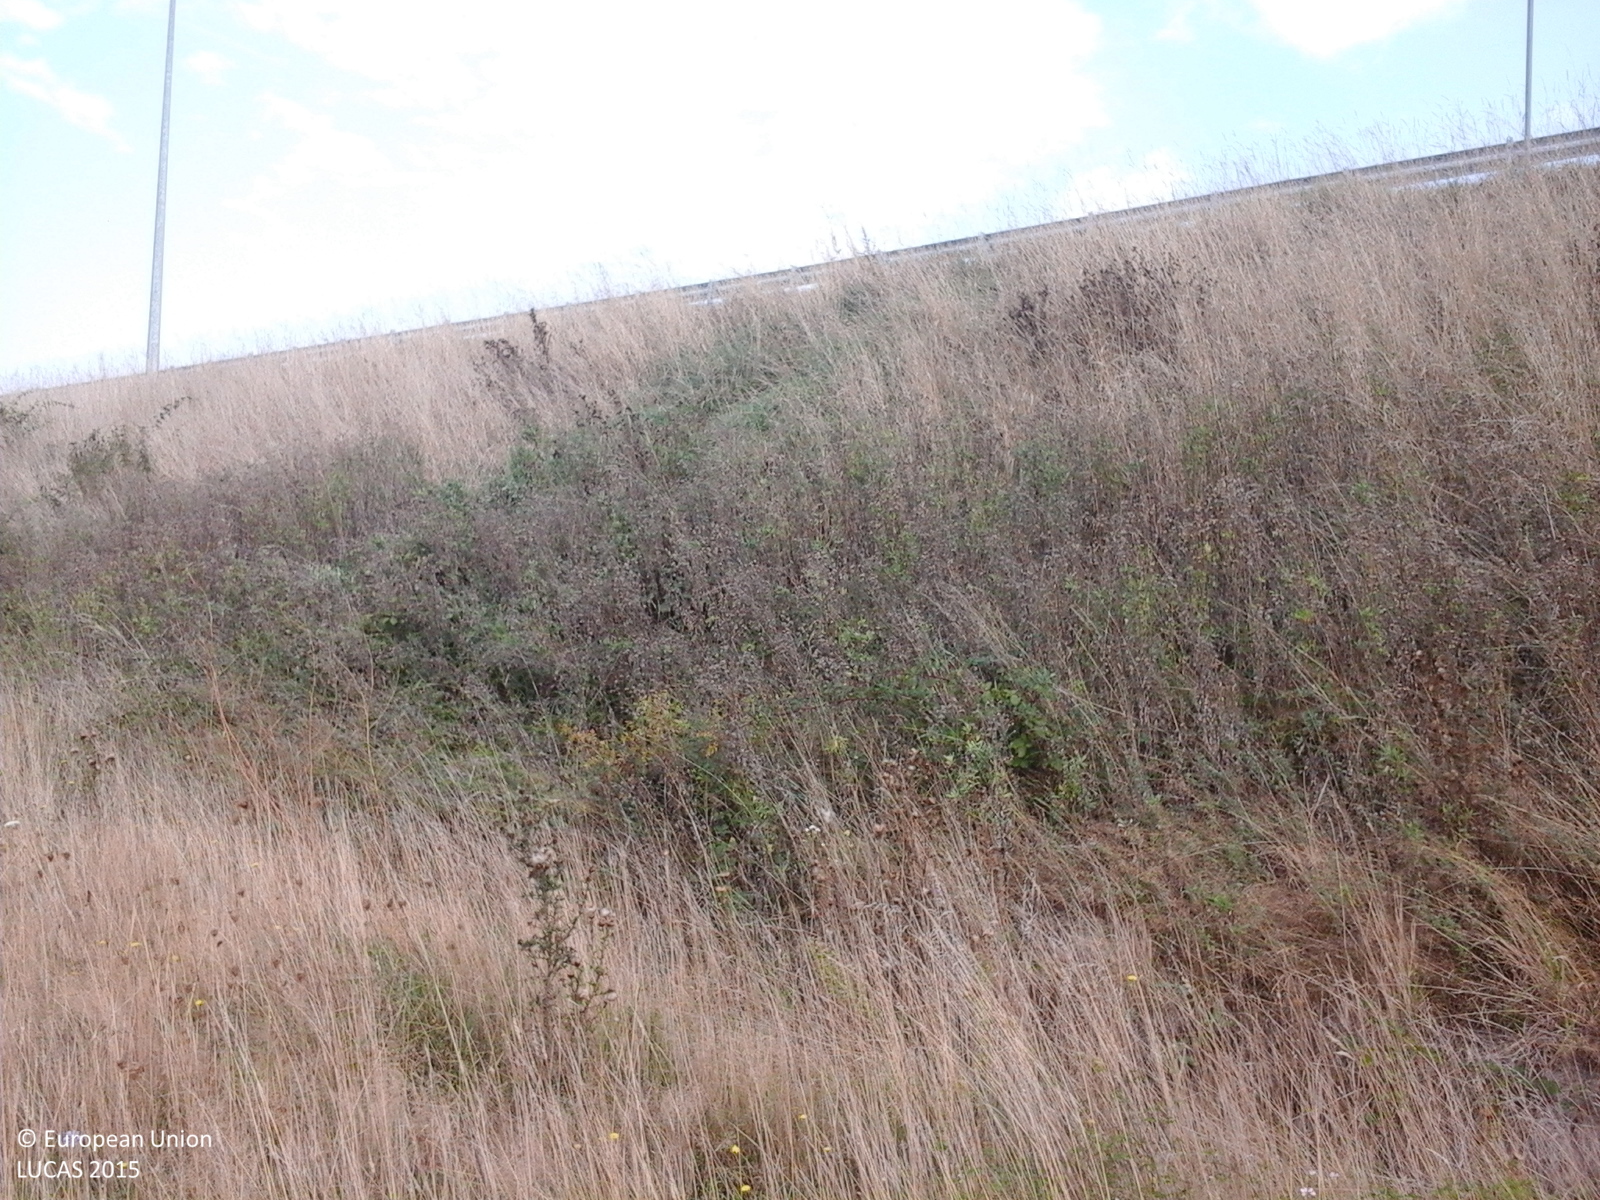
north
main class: Grassland
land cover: Spontaneously vegetated surfaces
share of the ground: > 75 %
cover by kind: herbaceous plants 100 %
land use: Protection infrastructures
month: September
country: RO
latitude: 45.4466
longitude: 22.2258
